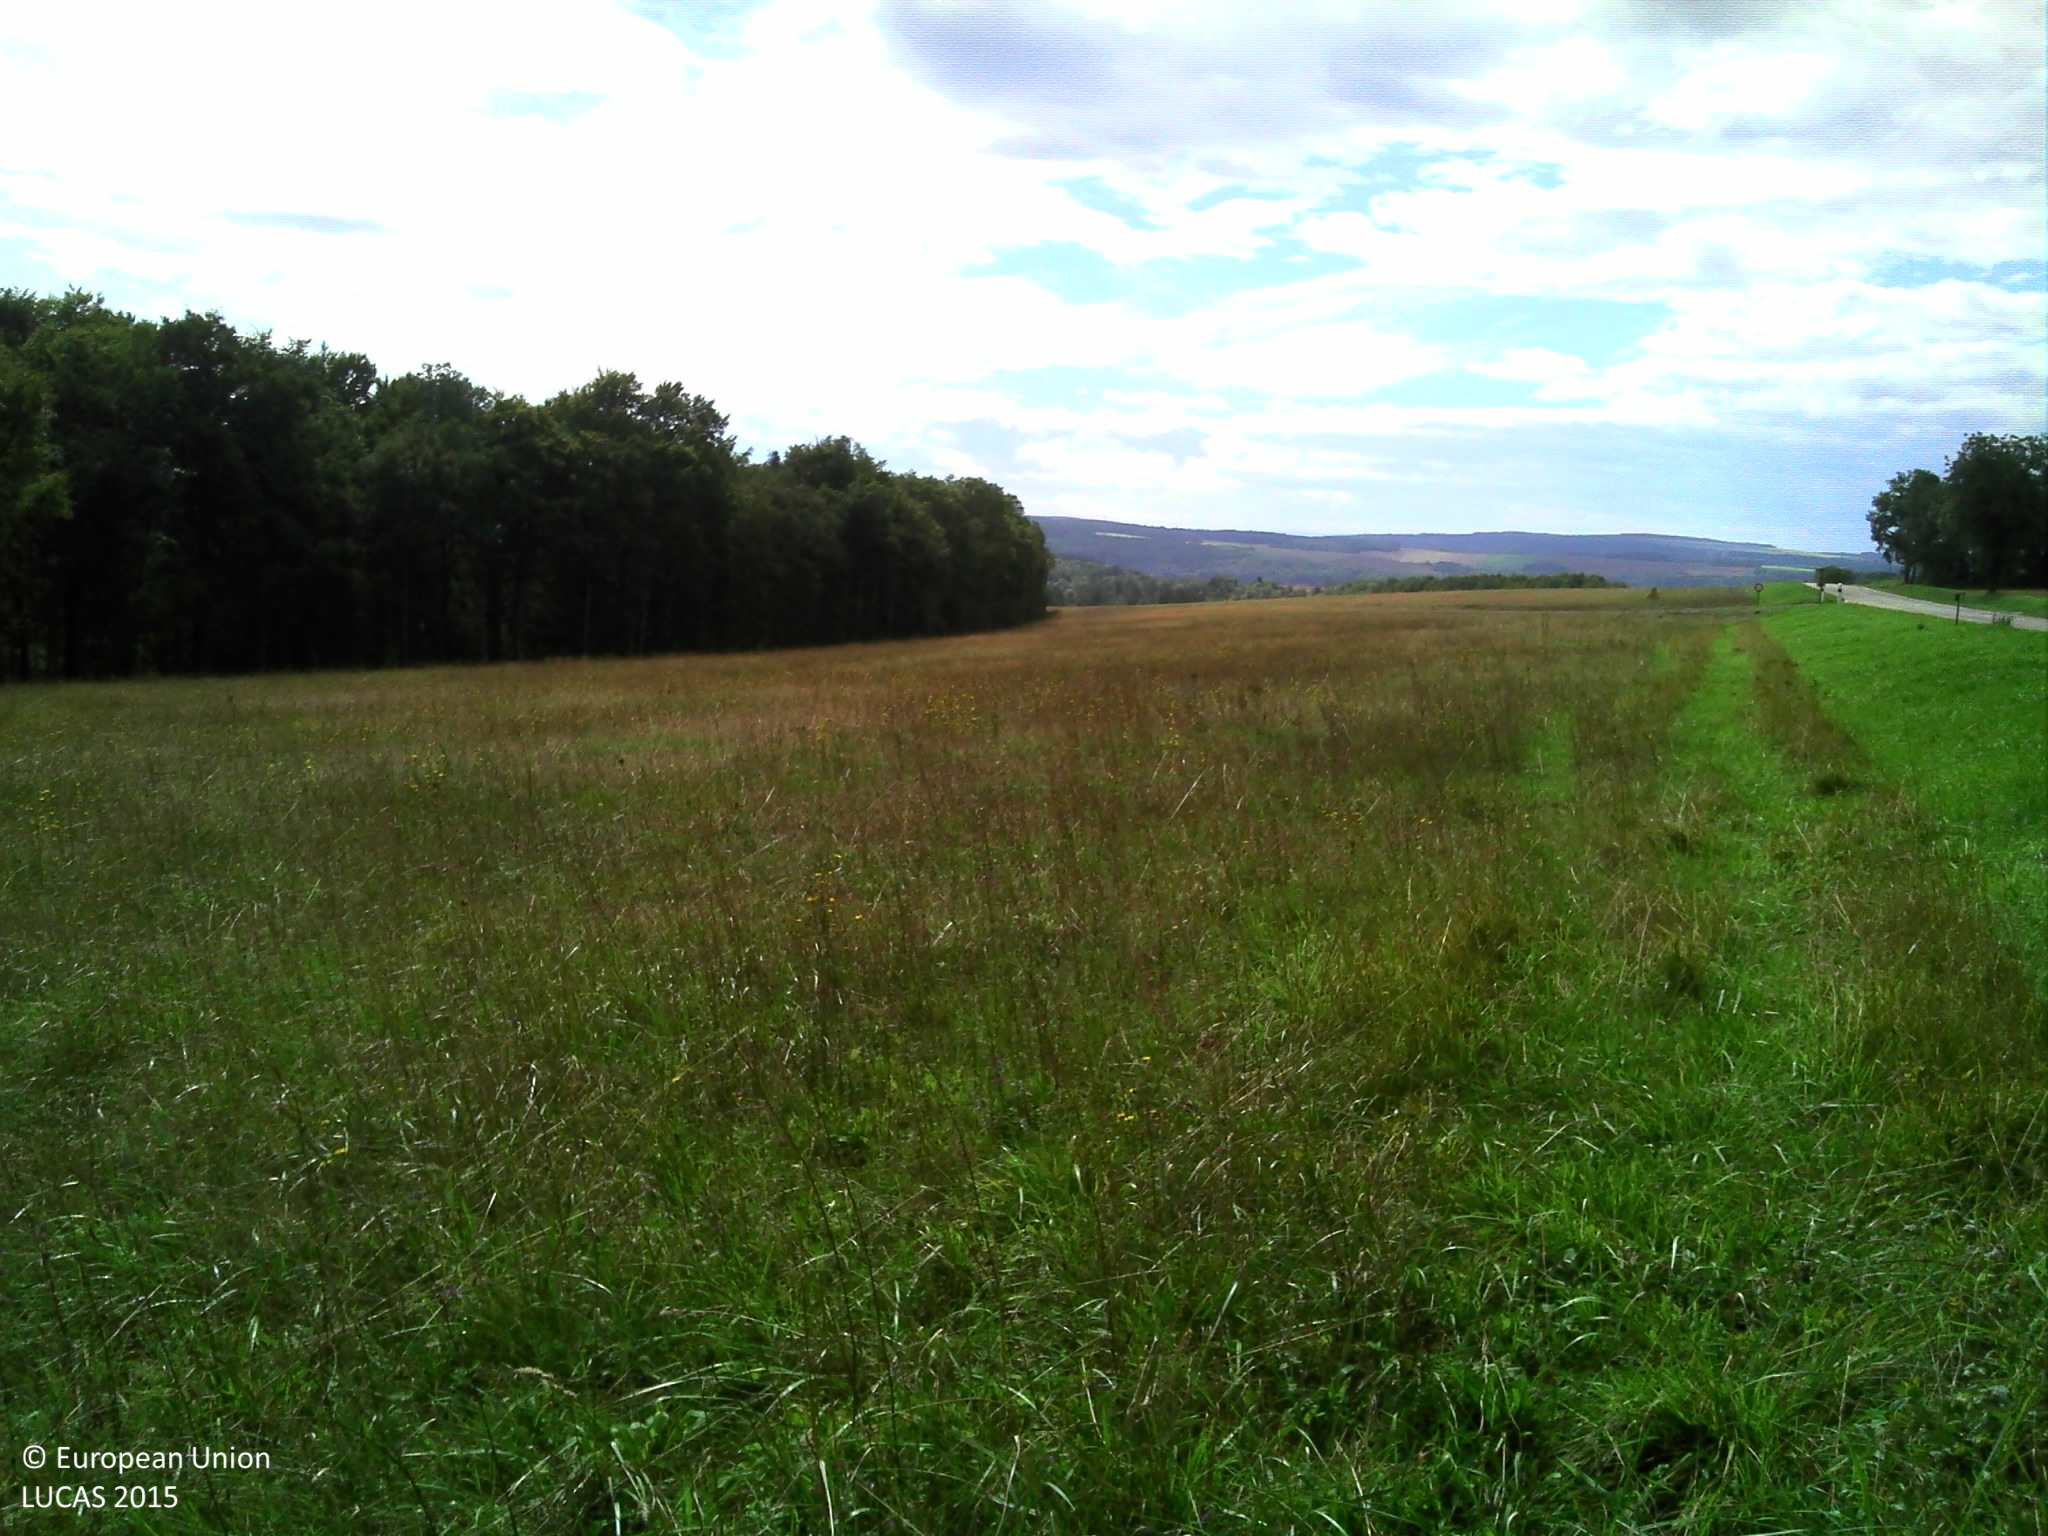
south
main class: Grassland
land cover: Grassland without tree/shrub cover
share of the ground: > 75 %
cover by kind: herbaceous plants 100 %
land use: Agriculture (excluding fallow land and kitchen gardens)
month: September
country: FR
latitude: 47.6466
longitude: 4.3674
